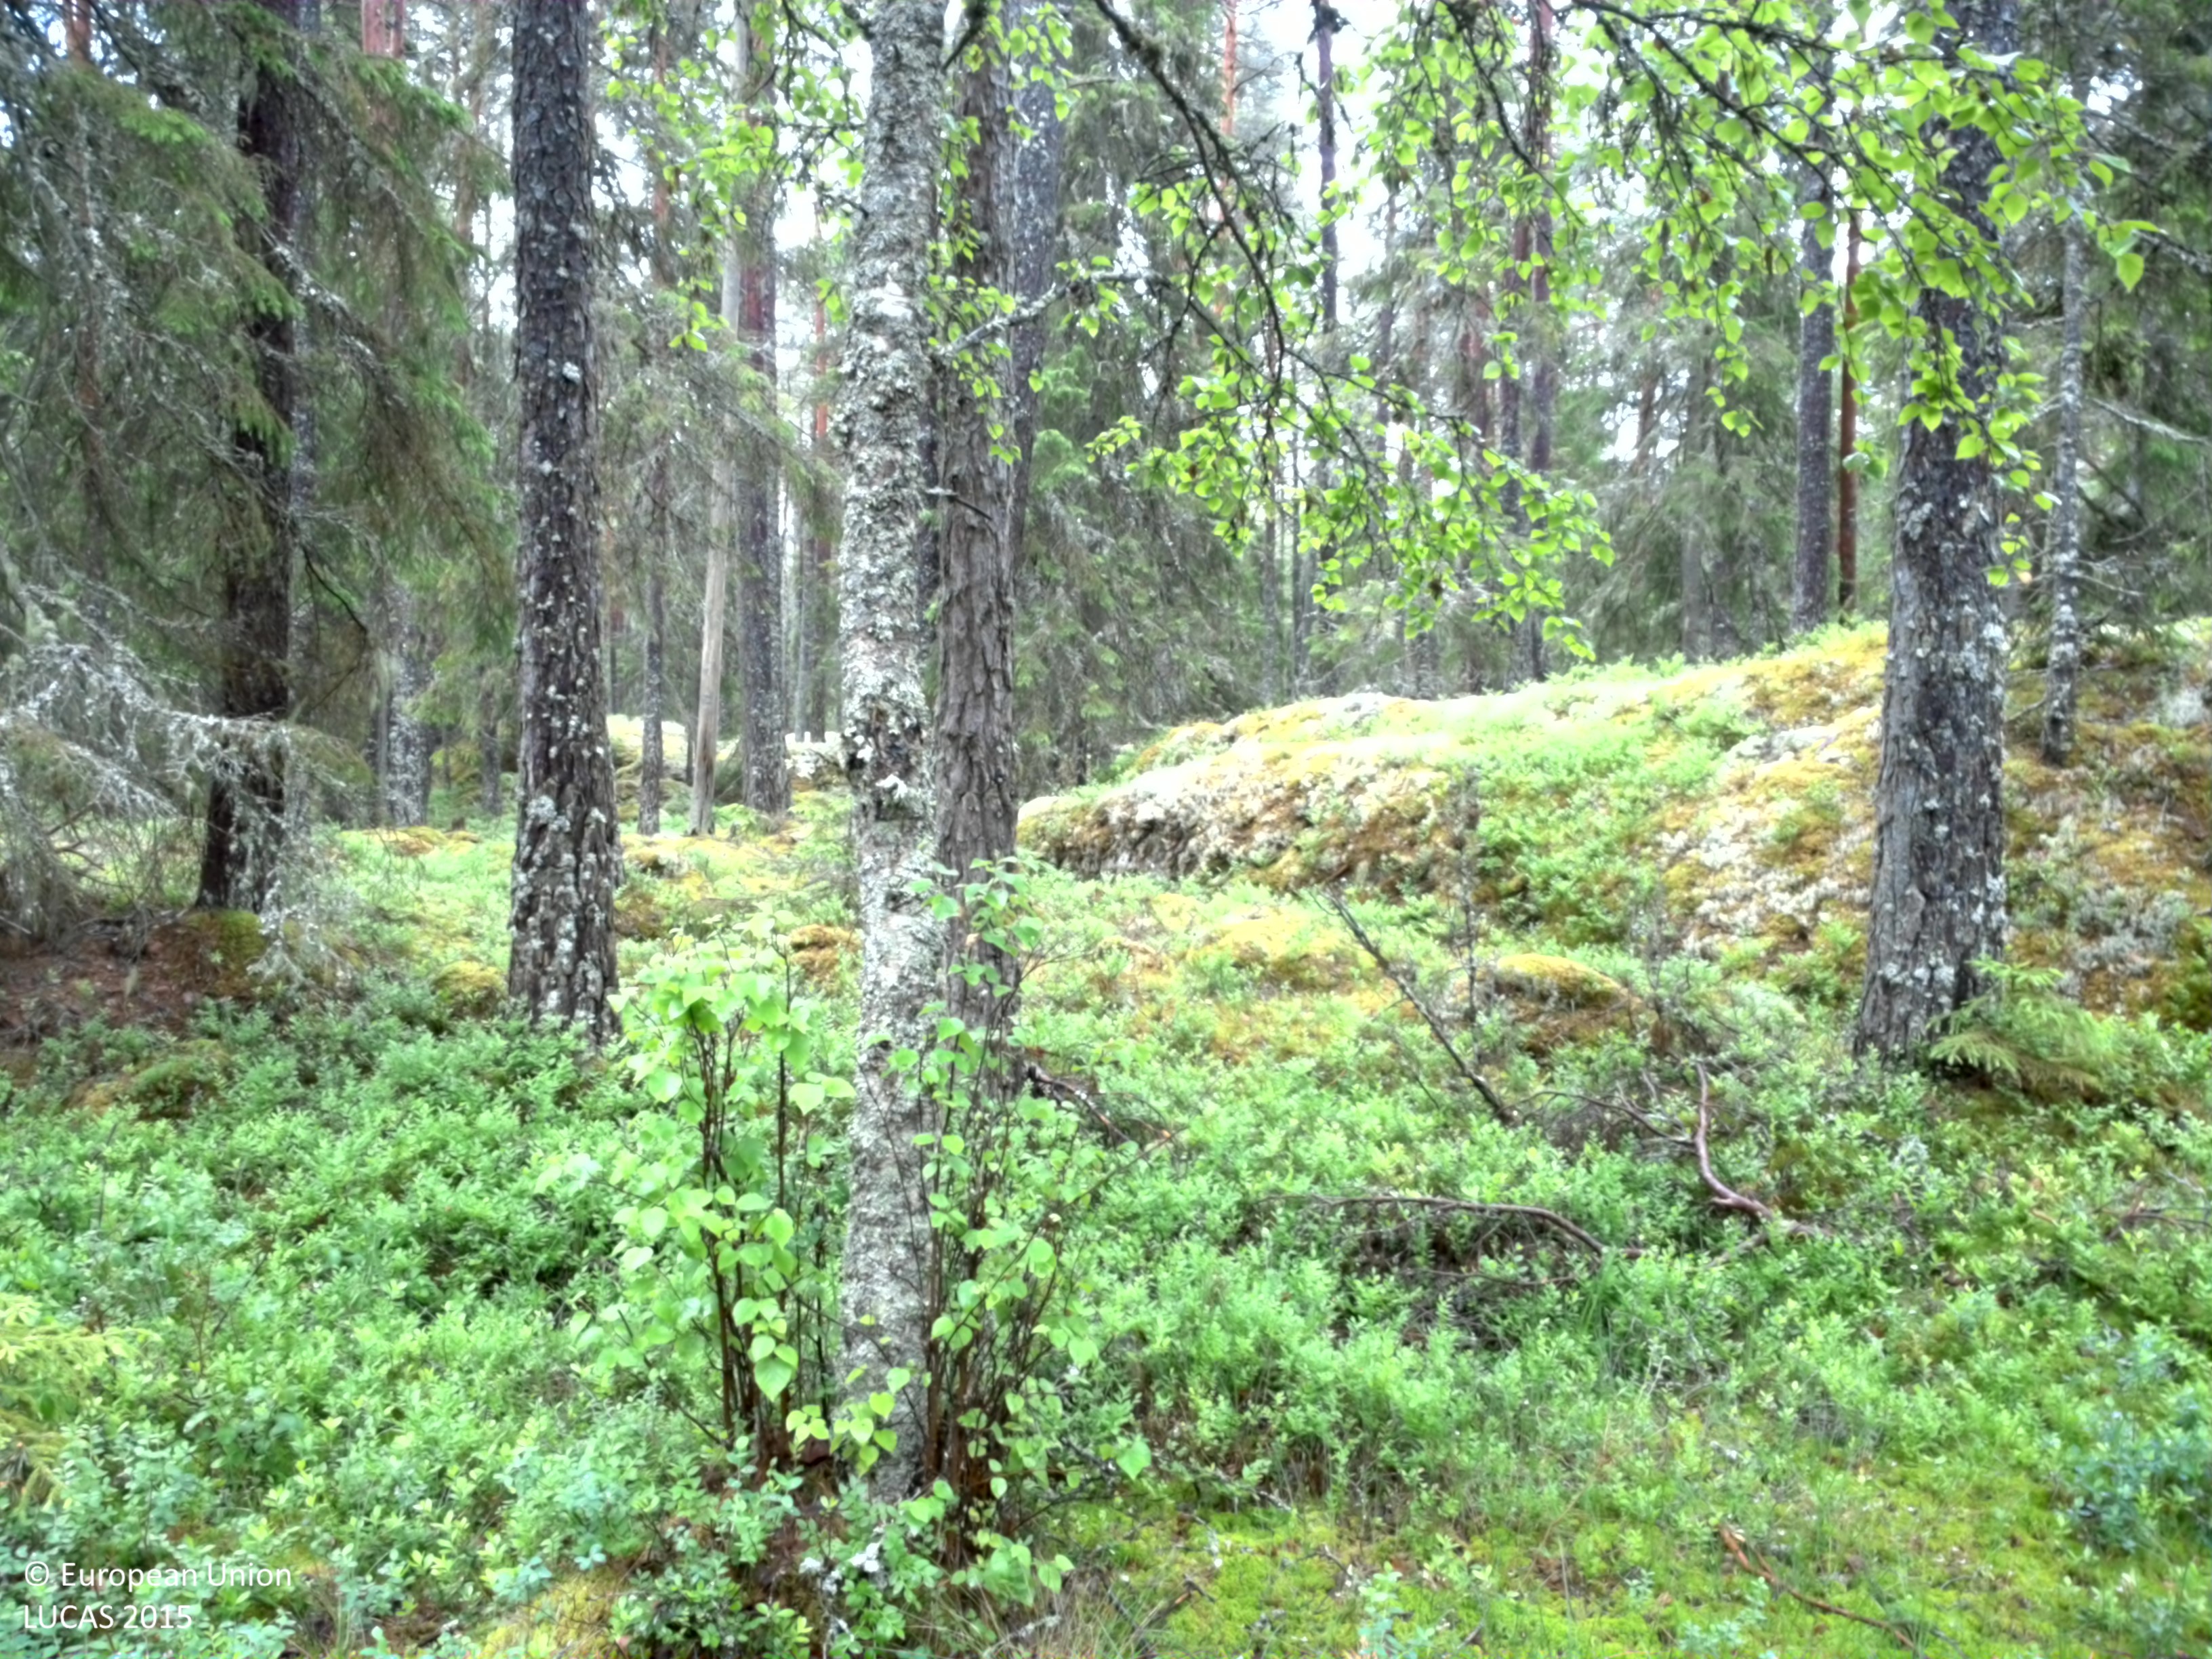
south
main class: Woodland
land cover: Pine dominated coniferous woodland
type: boreal forest
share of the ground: > 75 %
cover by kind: coniferous forest trees 80 %, broadleaved forest trees 10 %, lichens and mosses 10 %
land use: Amenities, museums, leisure
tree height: > 5 m
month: June
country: SE
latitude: 59.8366
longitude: 17.1476
